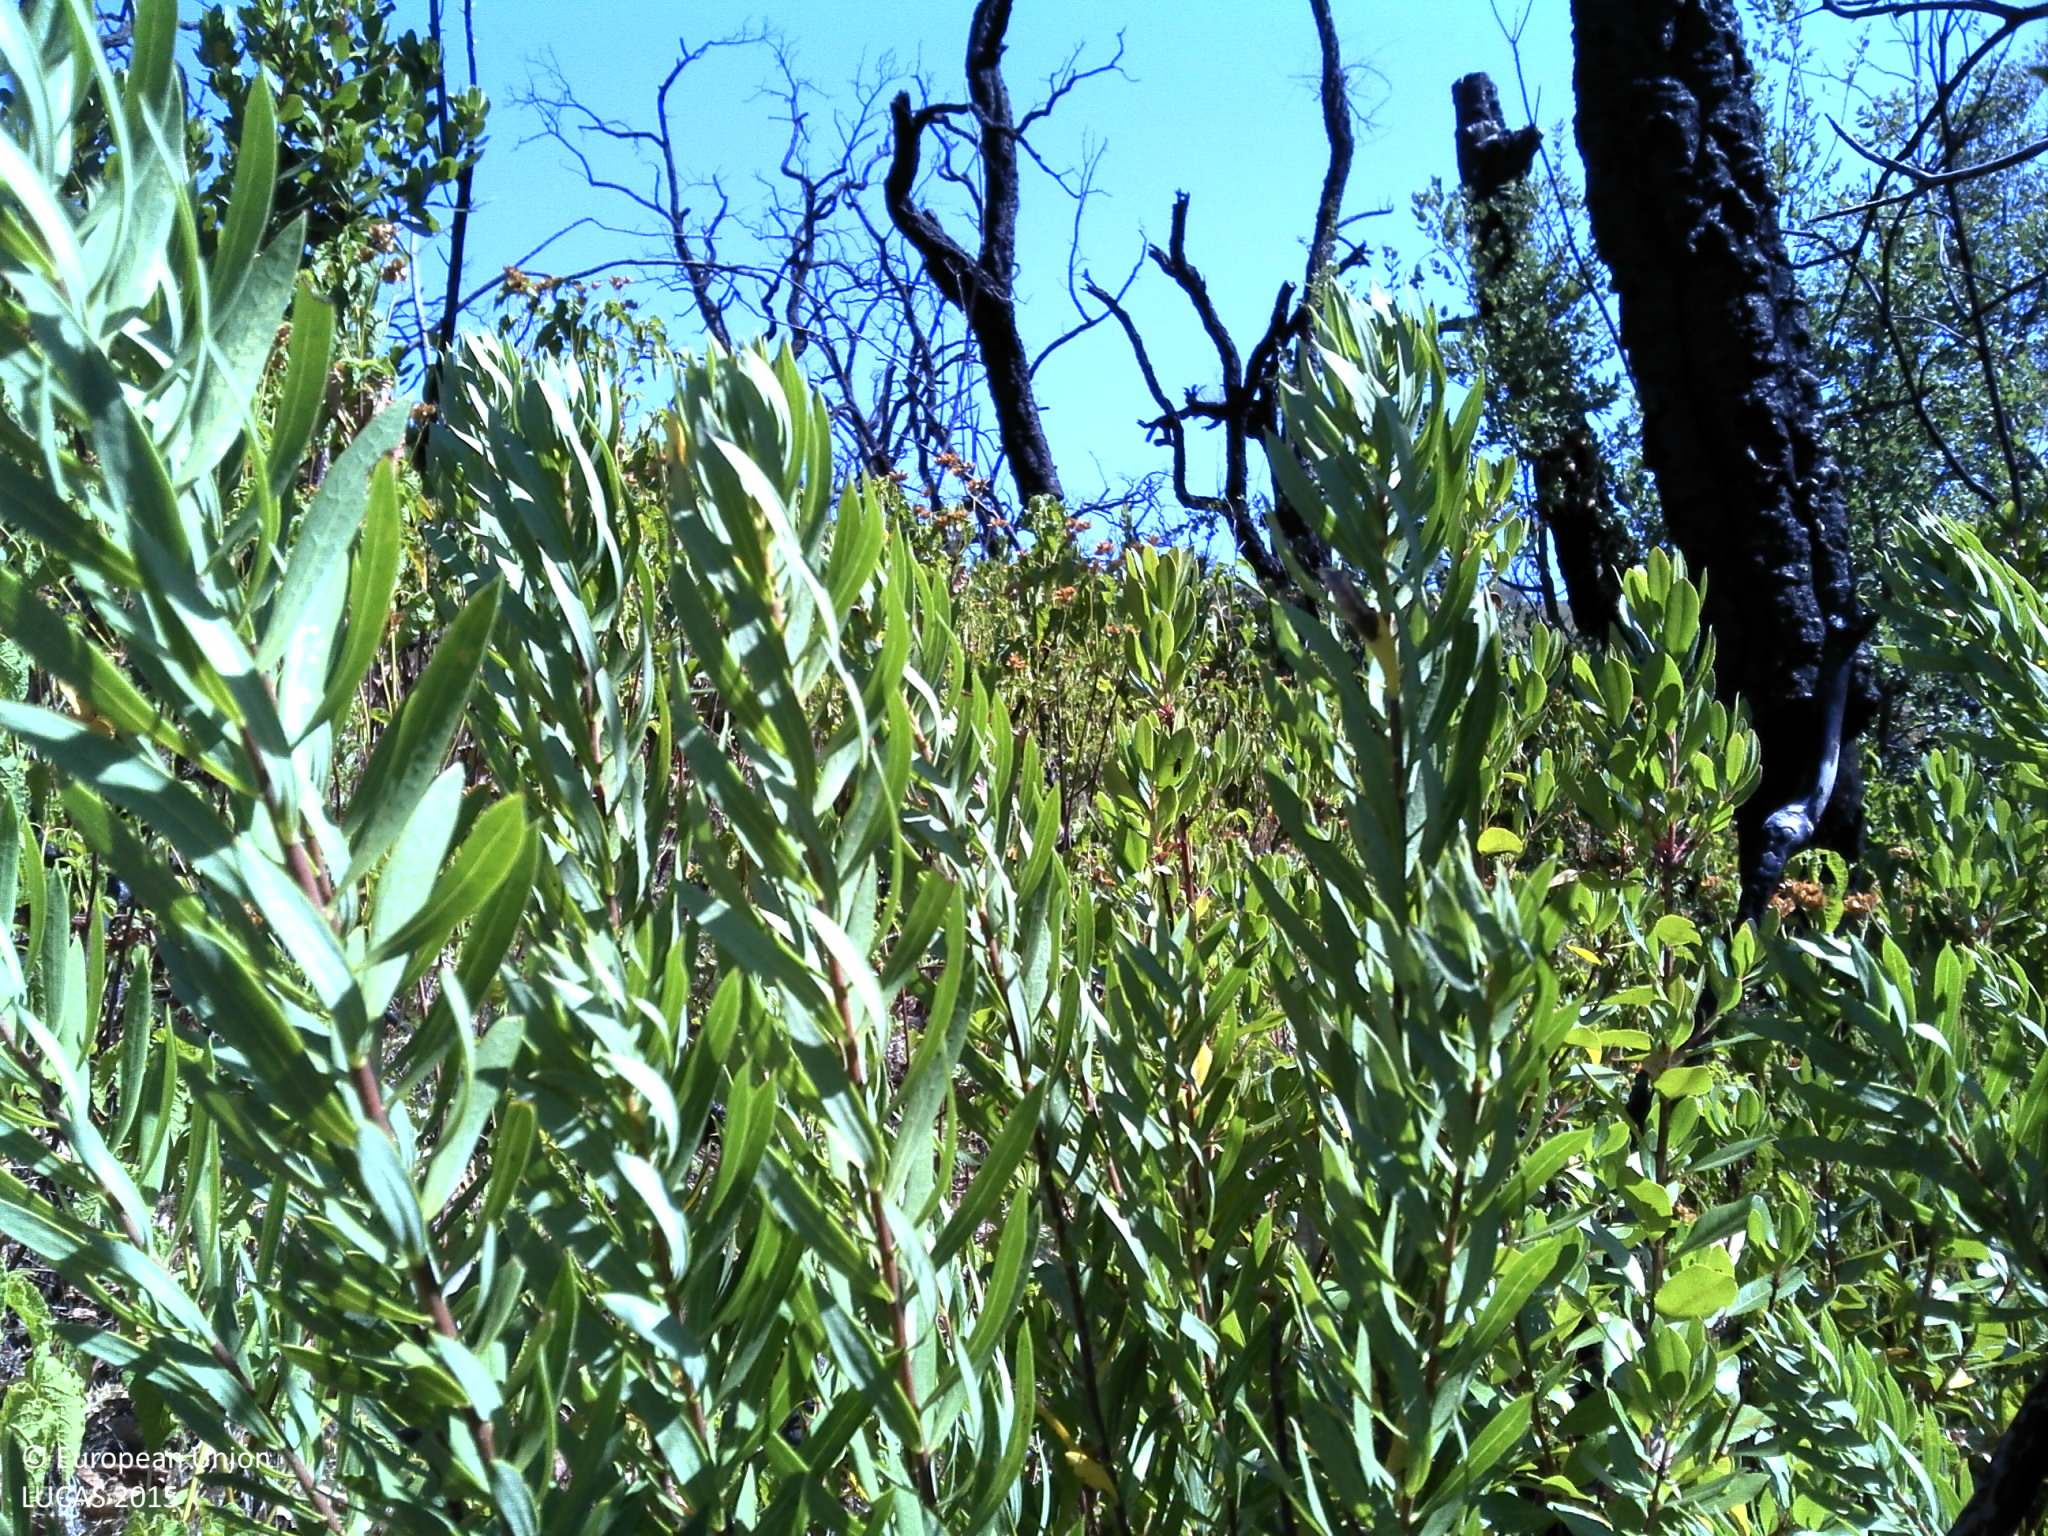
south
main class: Shrubland
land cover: Shrubland without tree cover
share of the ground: > 75 %
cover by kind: shrubs 90 %, herbaceous plants 5 %, unconsolidated bare surface 5 %
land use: Abandoned areas
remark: Burnt area
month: June
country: PT
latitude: 37.2103
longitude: -7.8483
